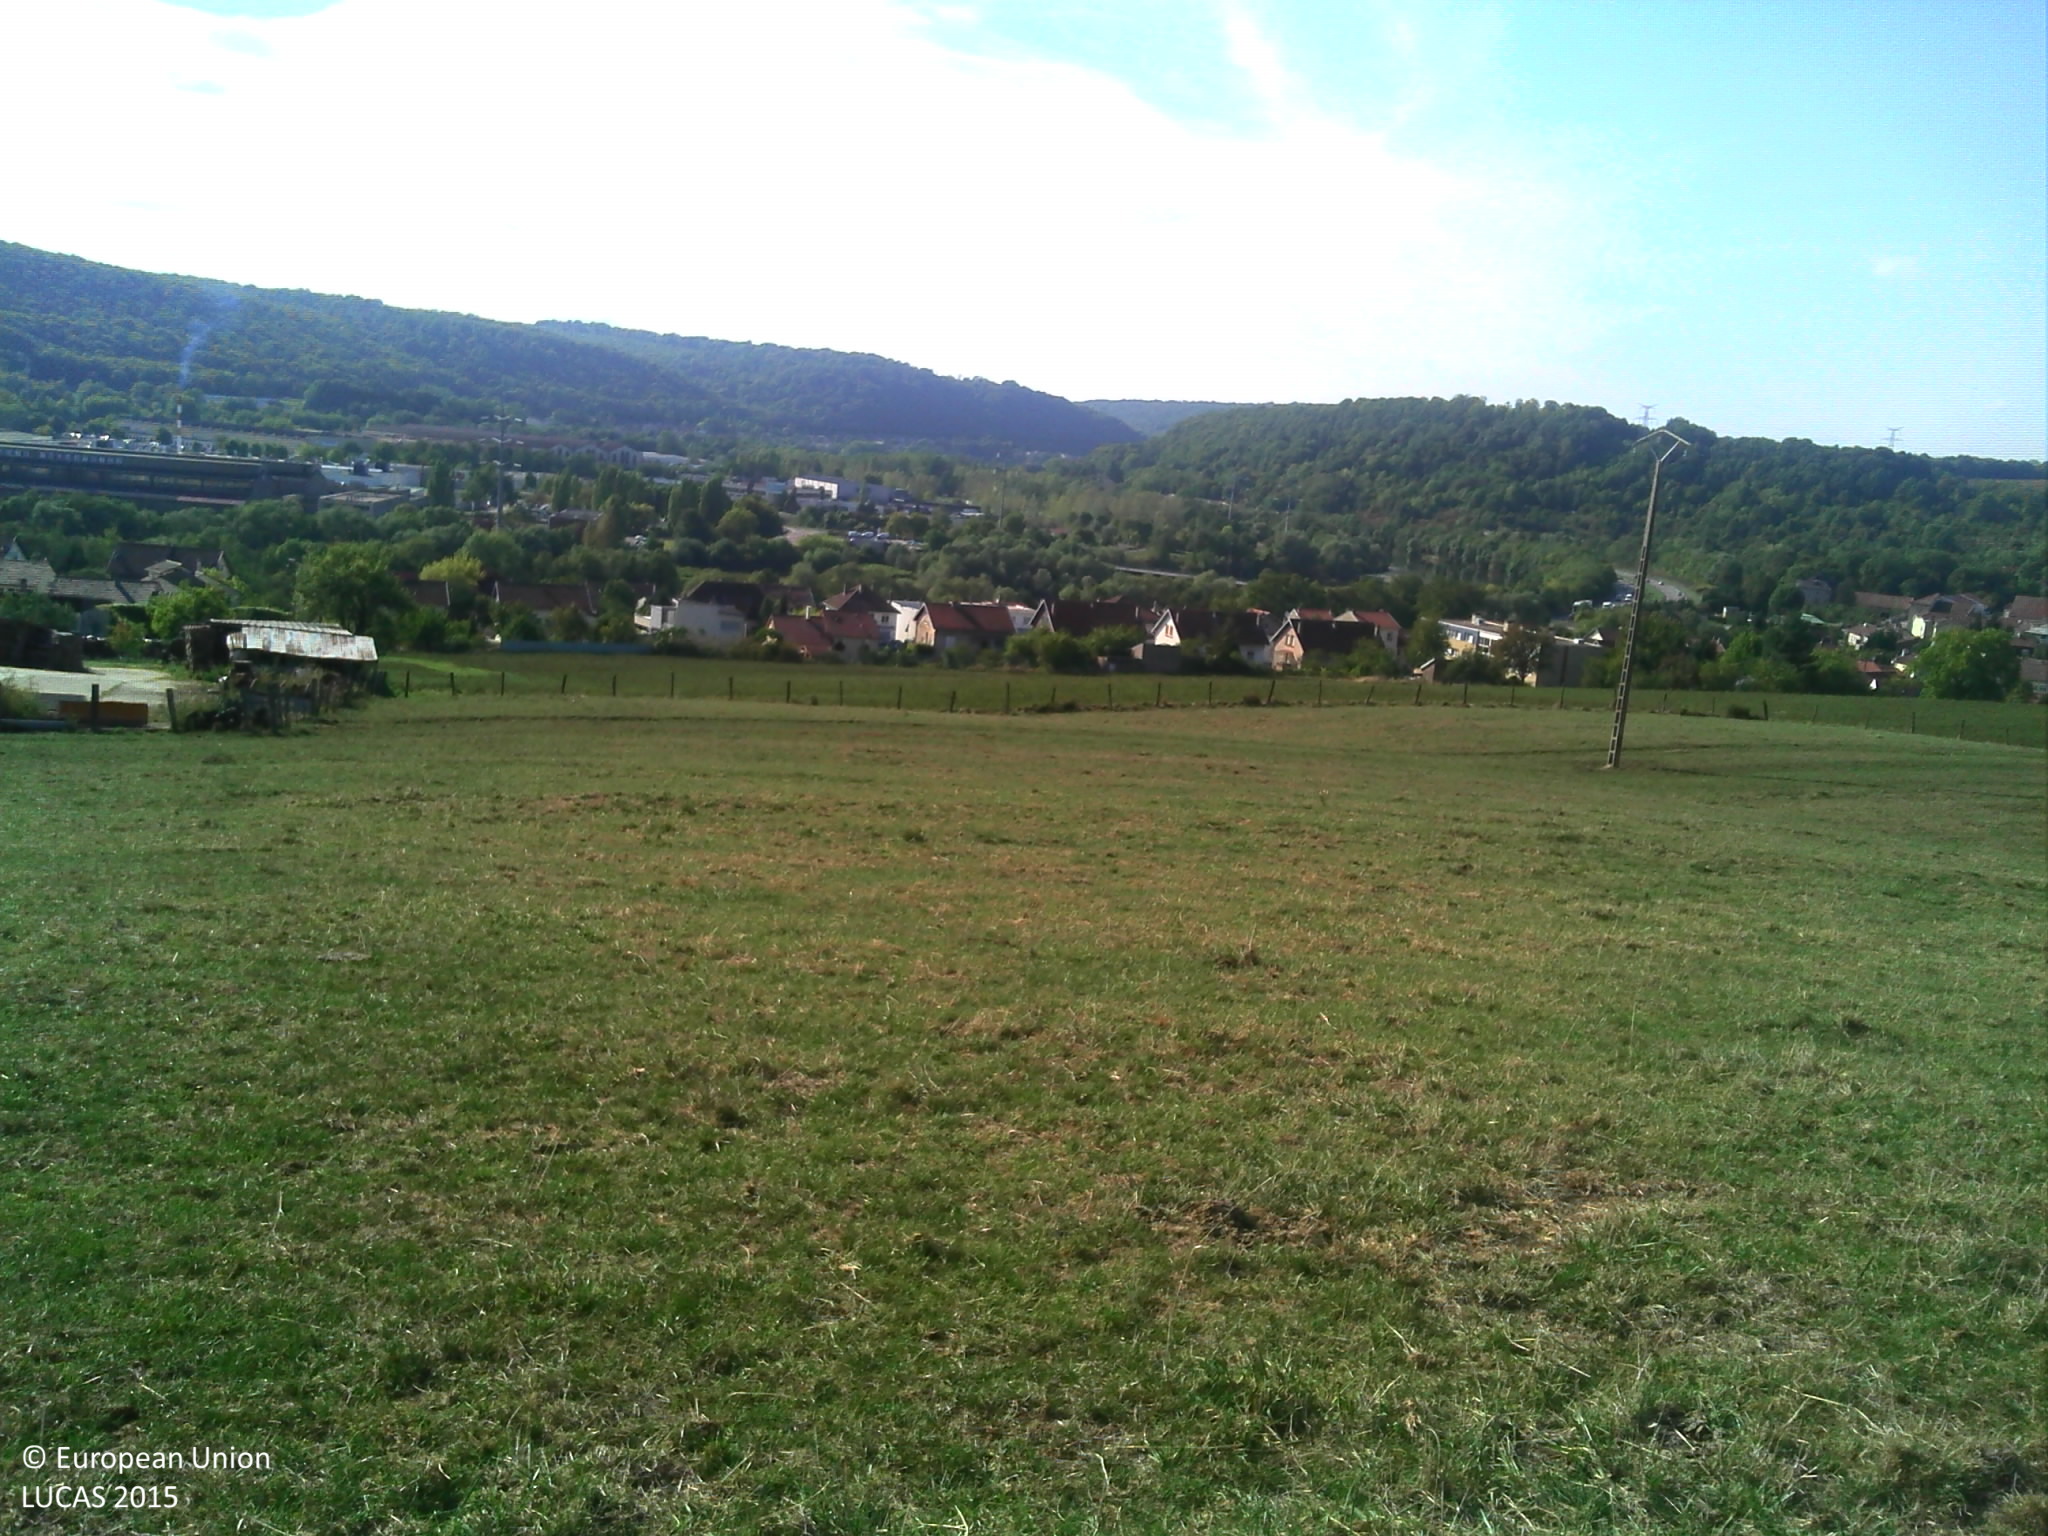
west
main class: Grassland
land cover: Grassland without tree/shrub cover
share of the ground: > 75 %
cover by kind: herbaceous plants 100 %
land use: Agriculture (excluding fallow land and kitchen gardens)
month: September
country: FR
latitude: 48.7867
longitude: 6.1481
